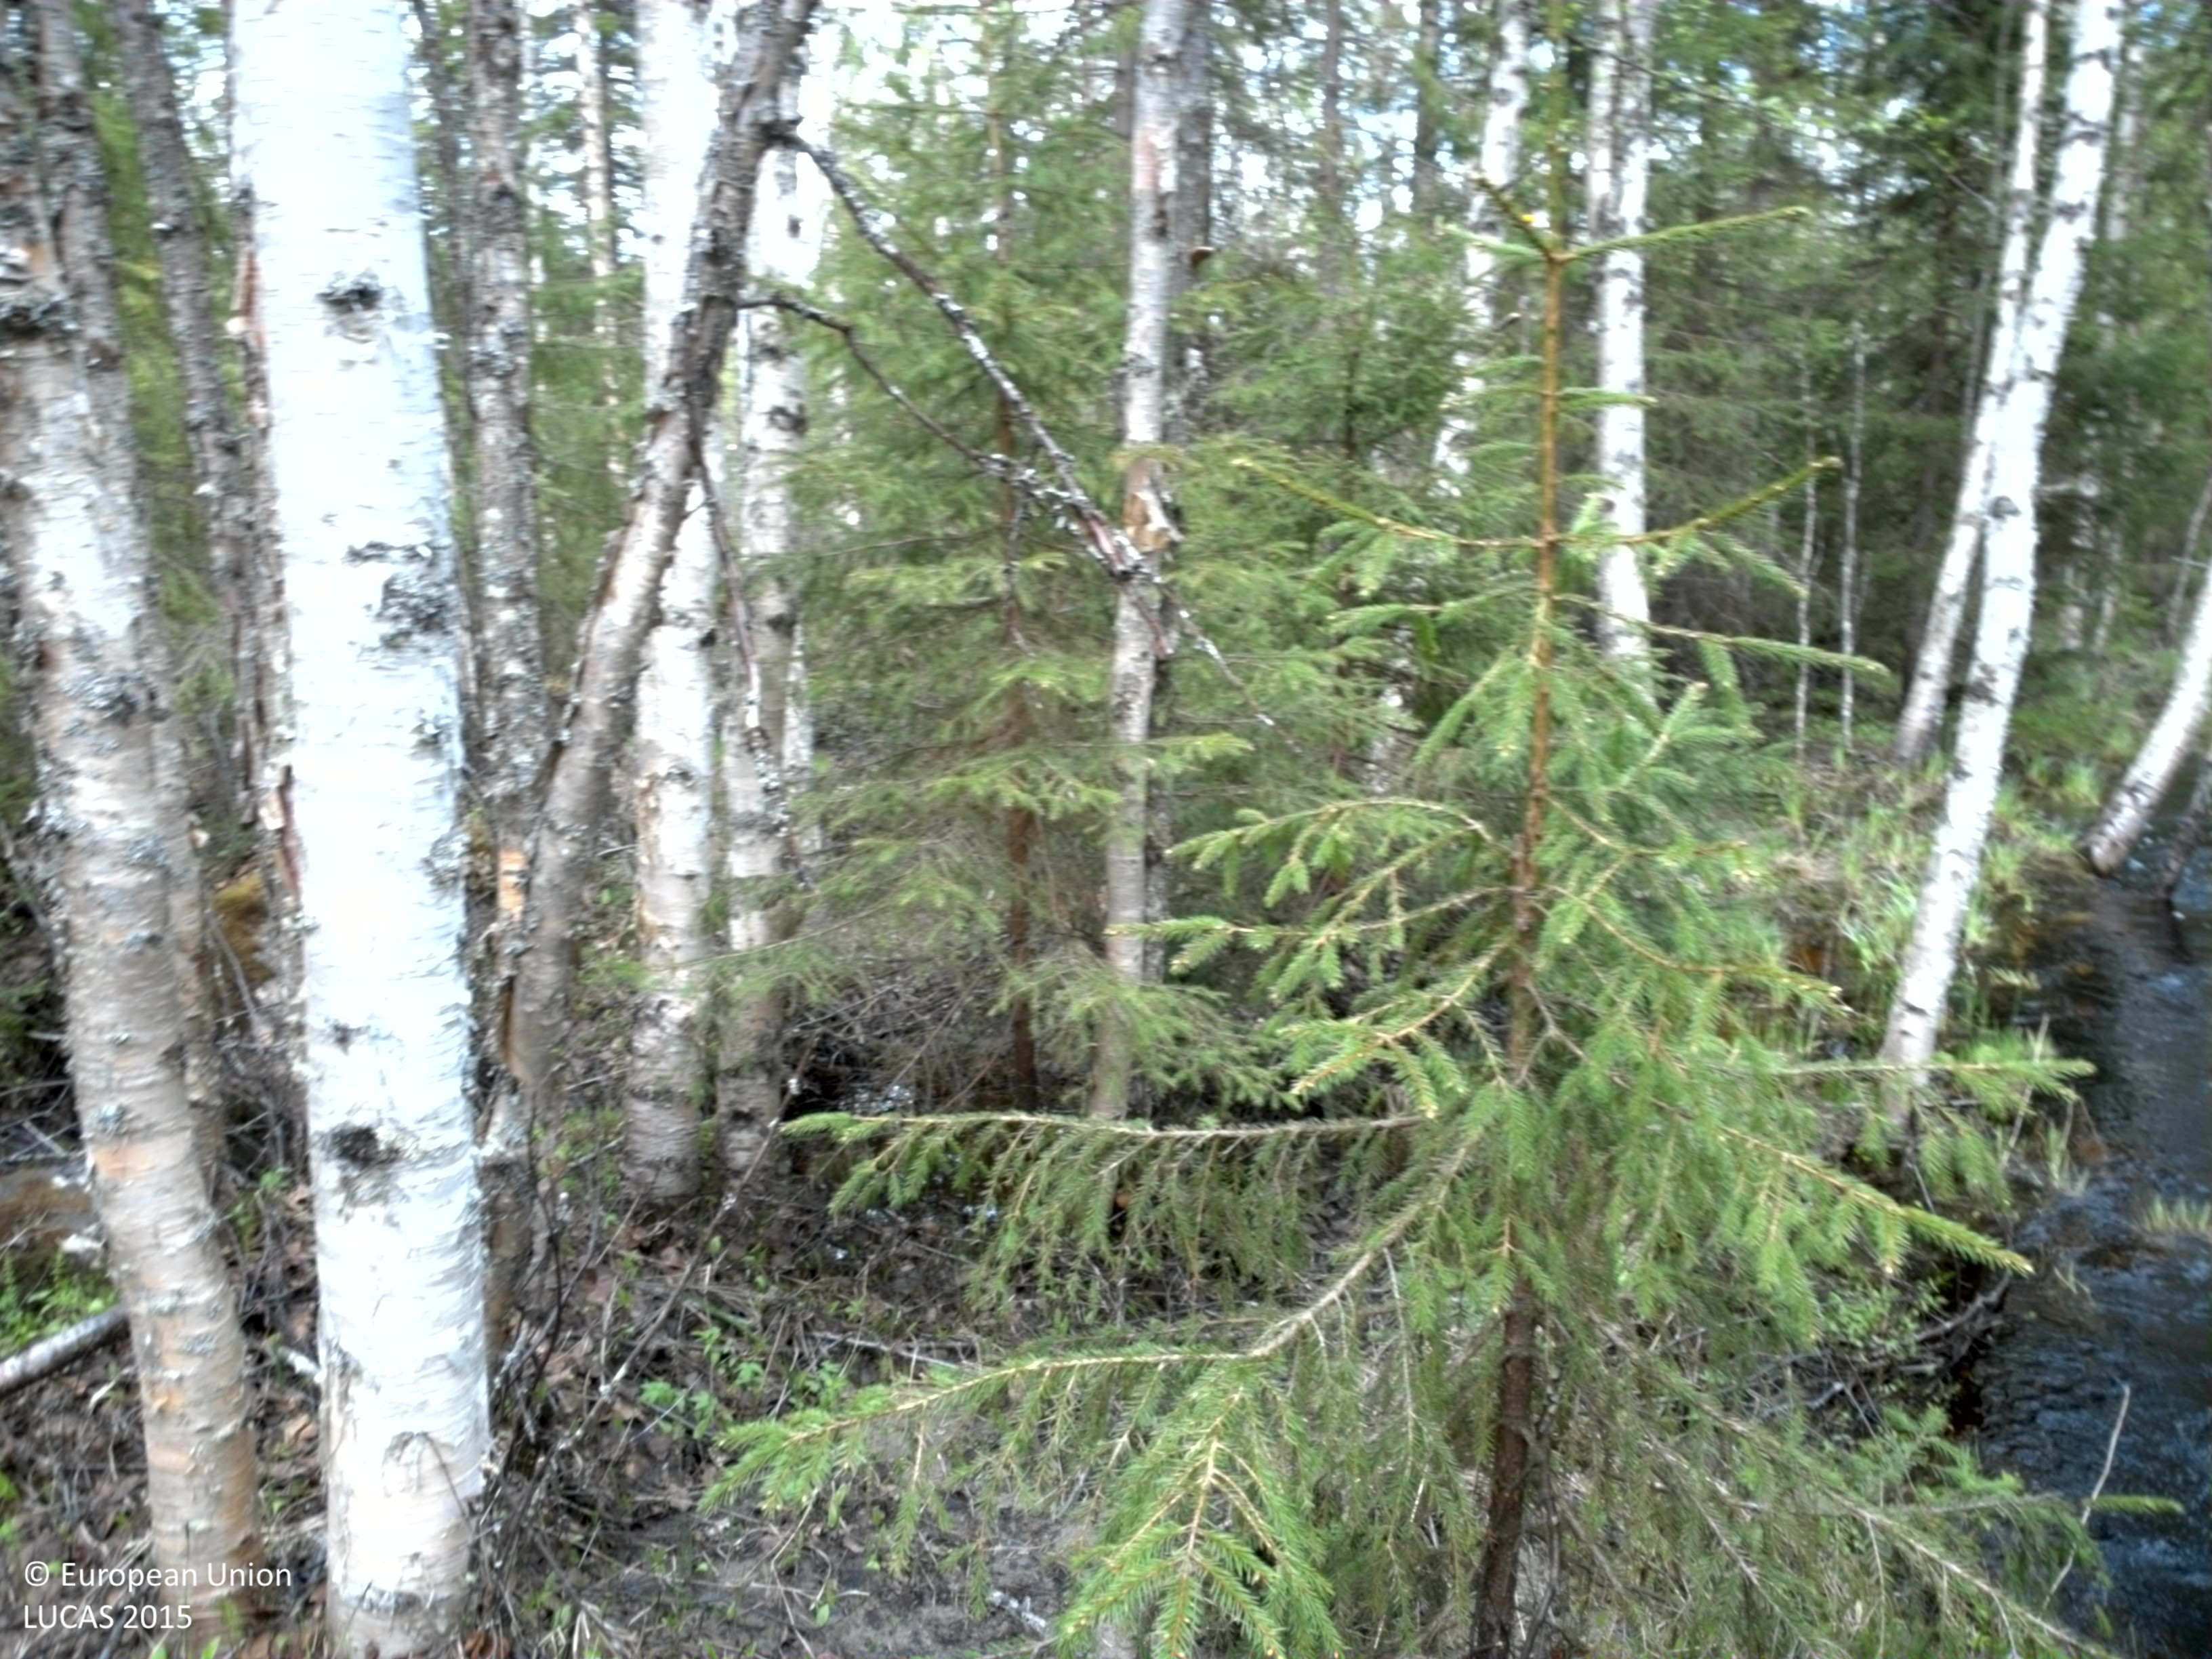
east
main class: Woodland
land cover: Spruce dominated mixed woodland
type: mire and swamp forests
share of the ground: > 75 %
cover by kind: broadleaved forest trees 55 %, coniferous forest trees 30 %, shrubs 10 %, herbaceous plants 5 %
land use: Forestry
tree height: > 5 m
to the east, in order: Spruce dominated mixed woodland; Pine dominated mixed woodland; Pine dominated coniferous woodland; Pine dominated mixed woodland; Spruce dominated mixed woodland; Ditches and canals; Pine dominated mixed woodland
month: June
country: SE
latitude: 66.3248
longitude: 22.4940
